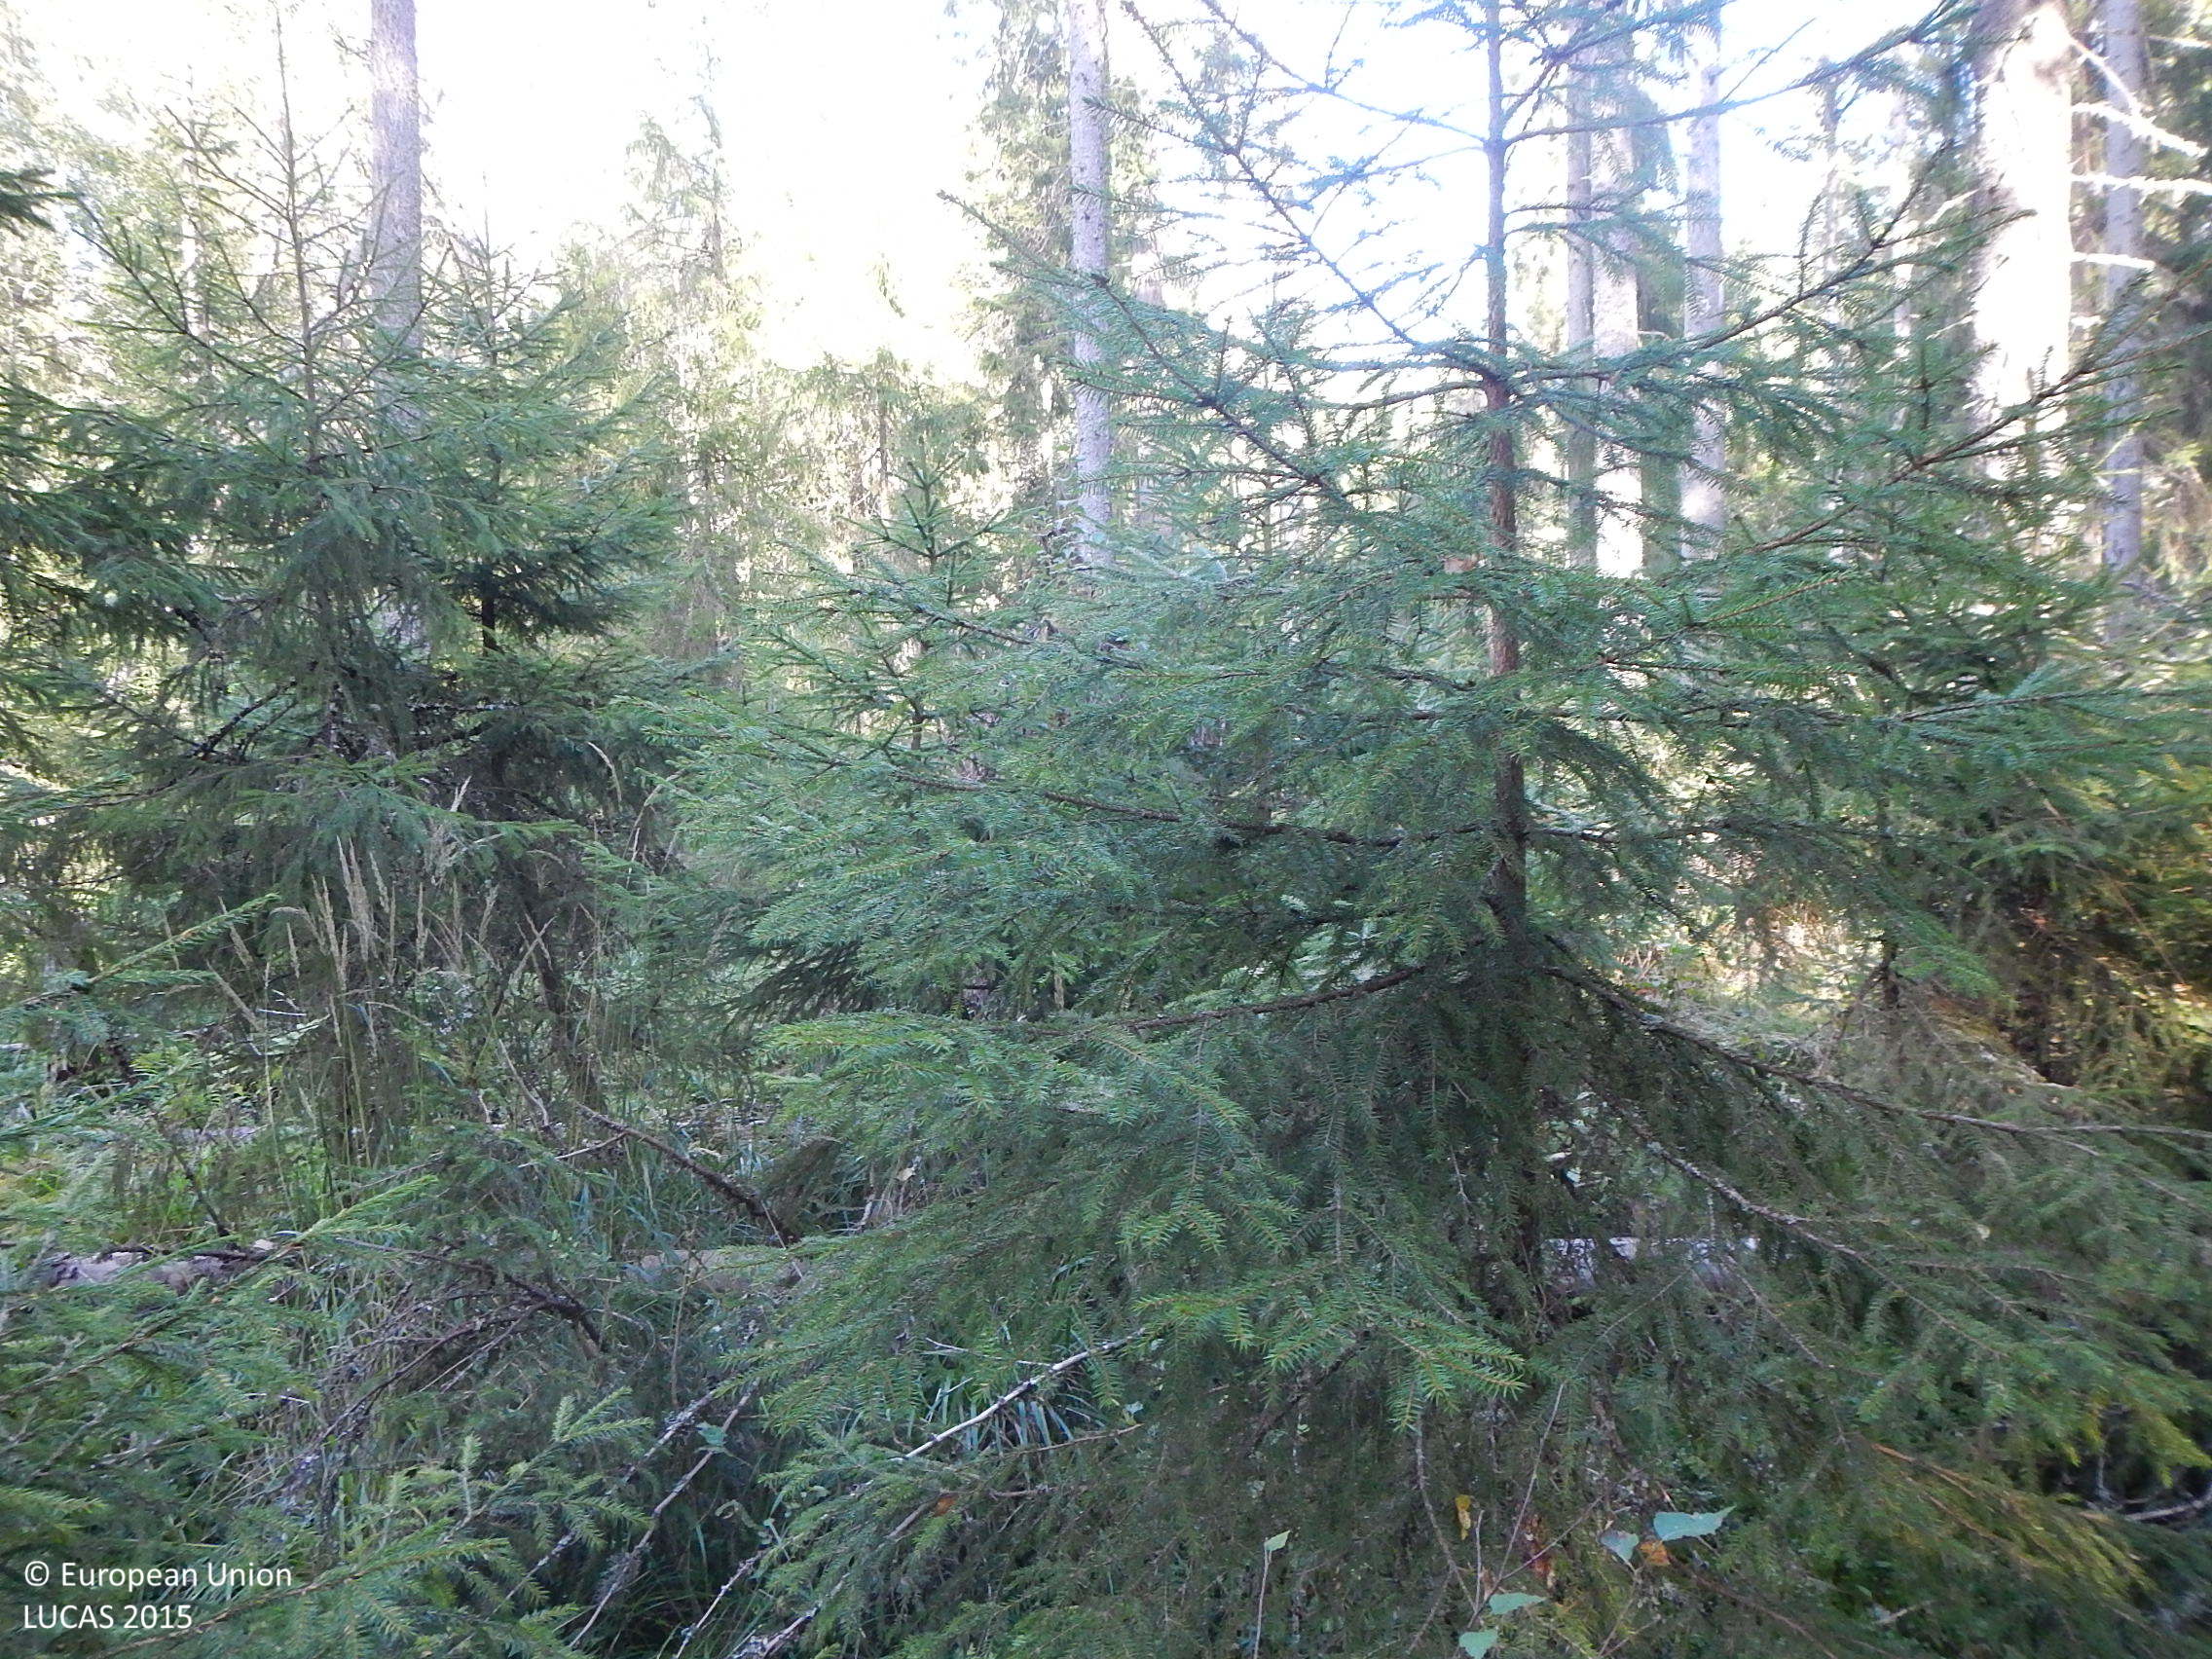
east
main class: Woodland
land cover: Spruce dominated coniferous woodland
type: boreal forest
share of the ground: > 75 %
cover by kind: coniferous forest trees 70 %, shrubs 20 %, broadleaved forest trees 10 %
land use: Forestry
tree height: > 5 m
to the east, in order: Spruce dominated coniferous woodland; Other mixed woodland; Tracks; Other mixed woodland; Spruce dominated mixed woodland
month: September
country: FI
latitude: 61.4865
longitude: 22.0569
